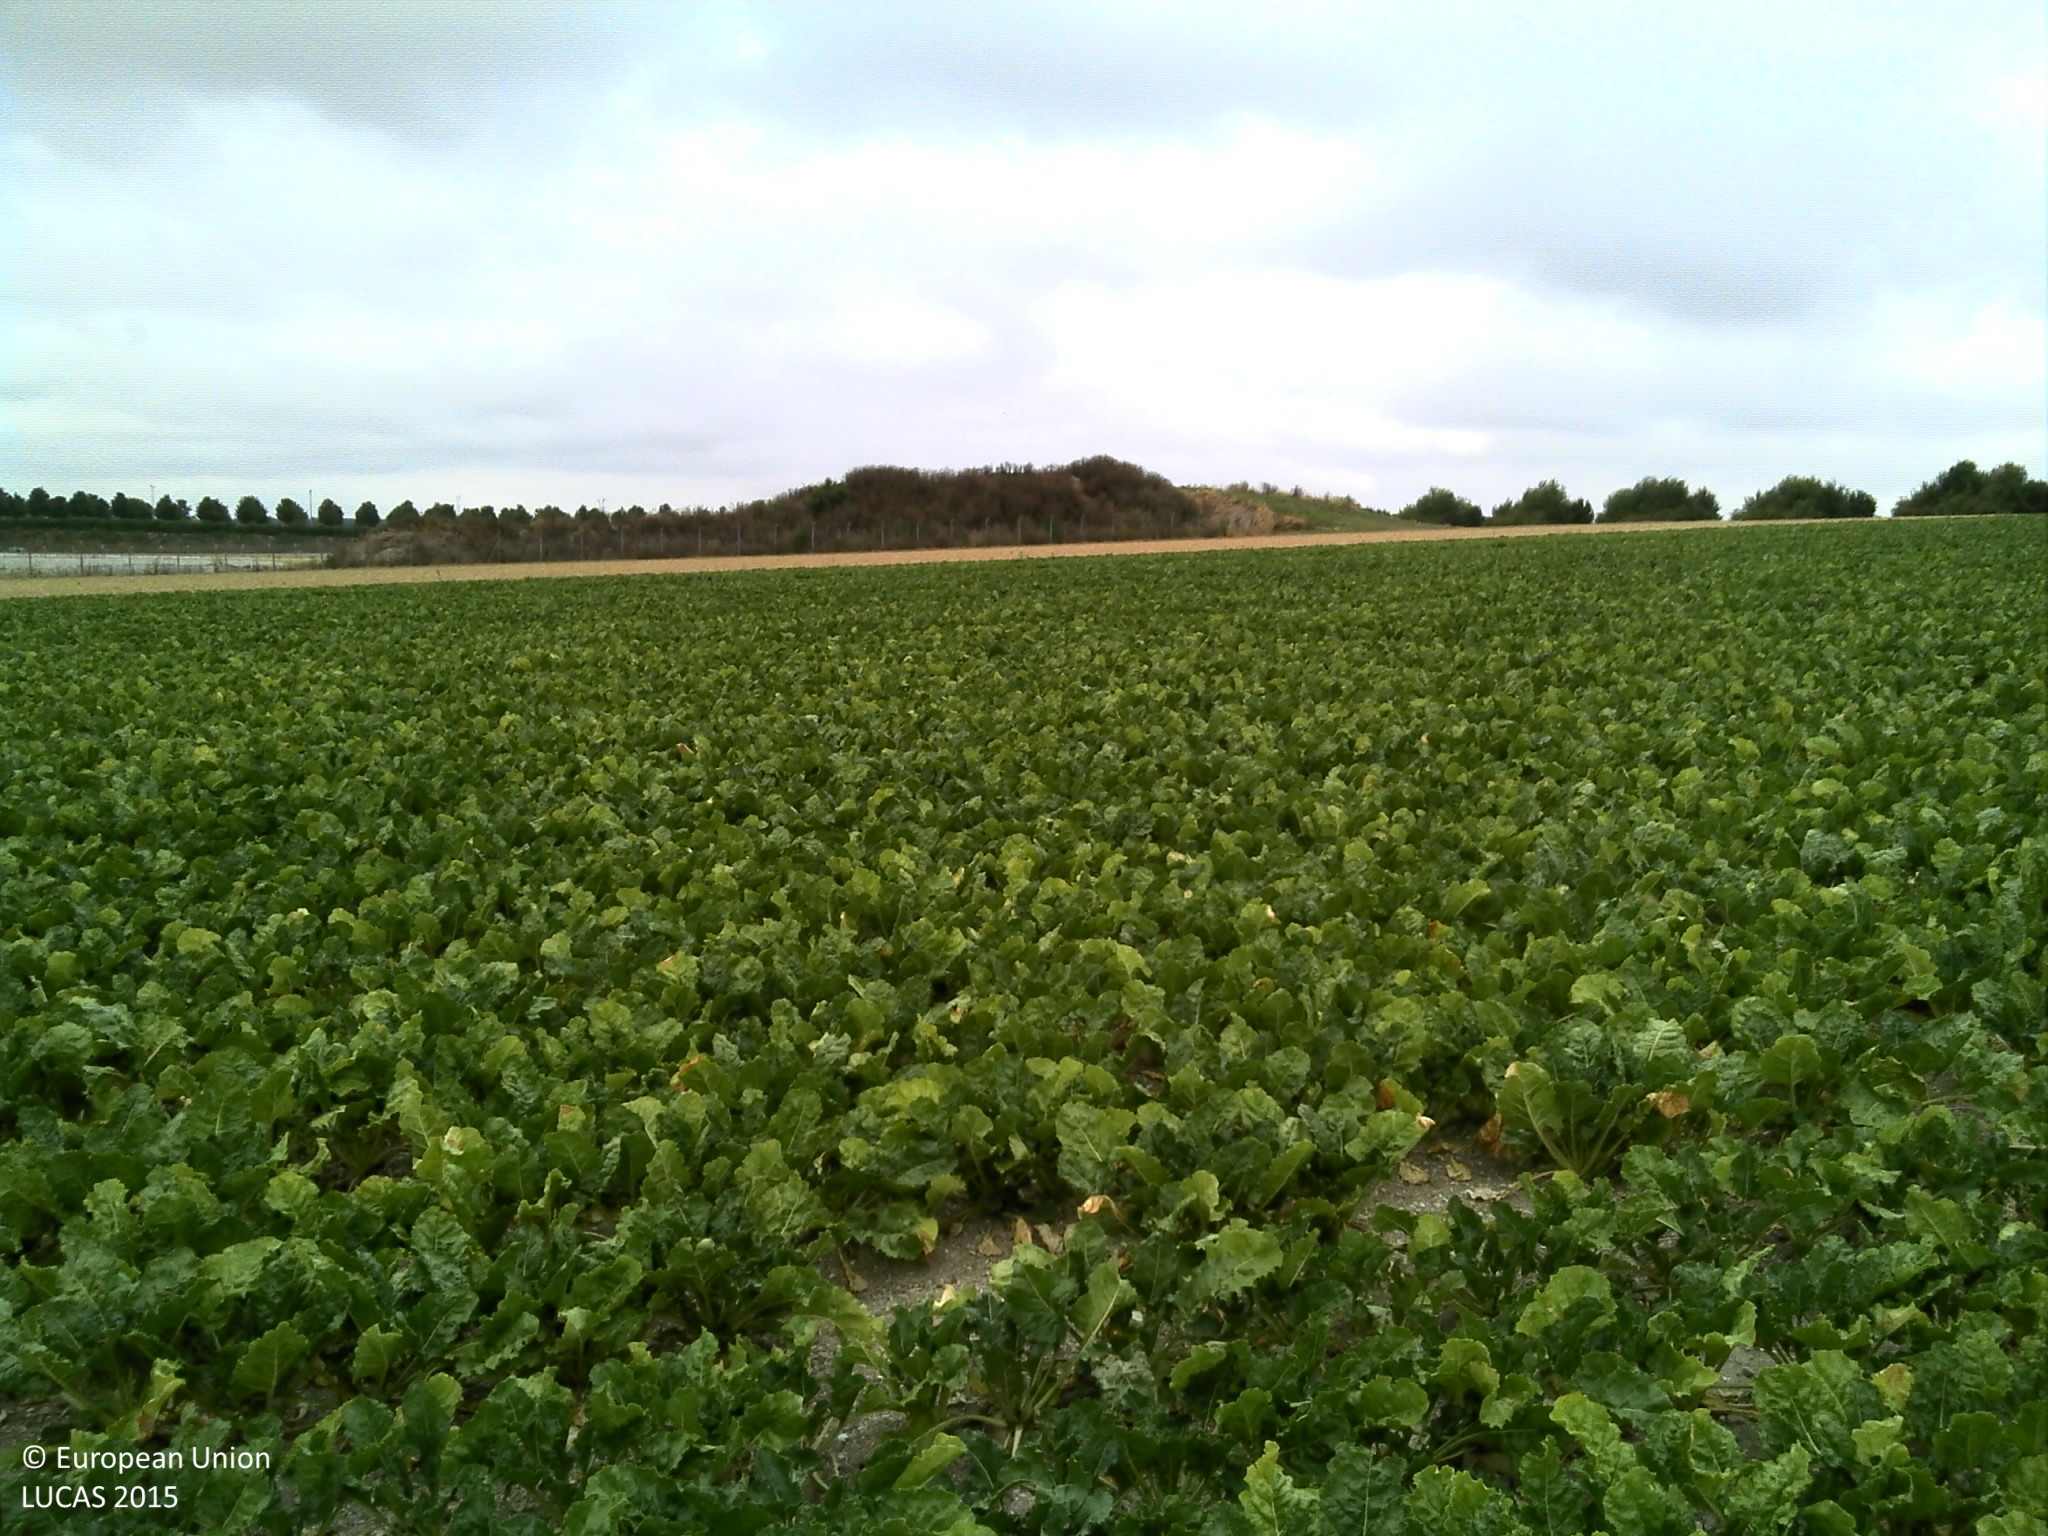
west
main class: Cropland
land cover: Sugar beet
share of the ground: 50 - 75 %
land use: Agriculture (excluding fallow land and kitchen gardens)
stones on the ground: < 10 %
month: August
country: FR
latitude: 48.7764
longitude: 4.2400
